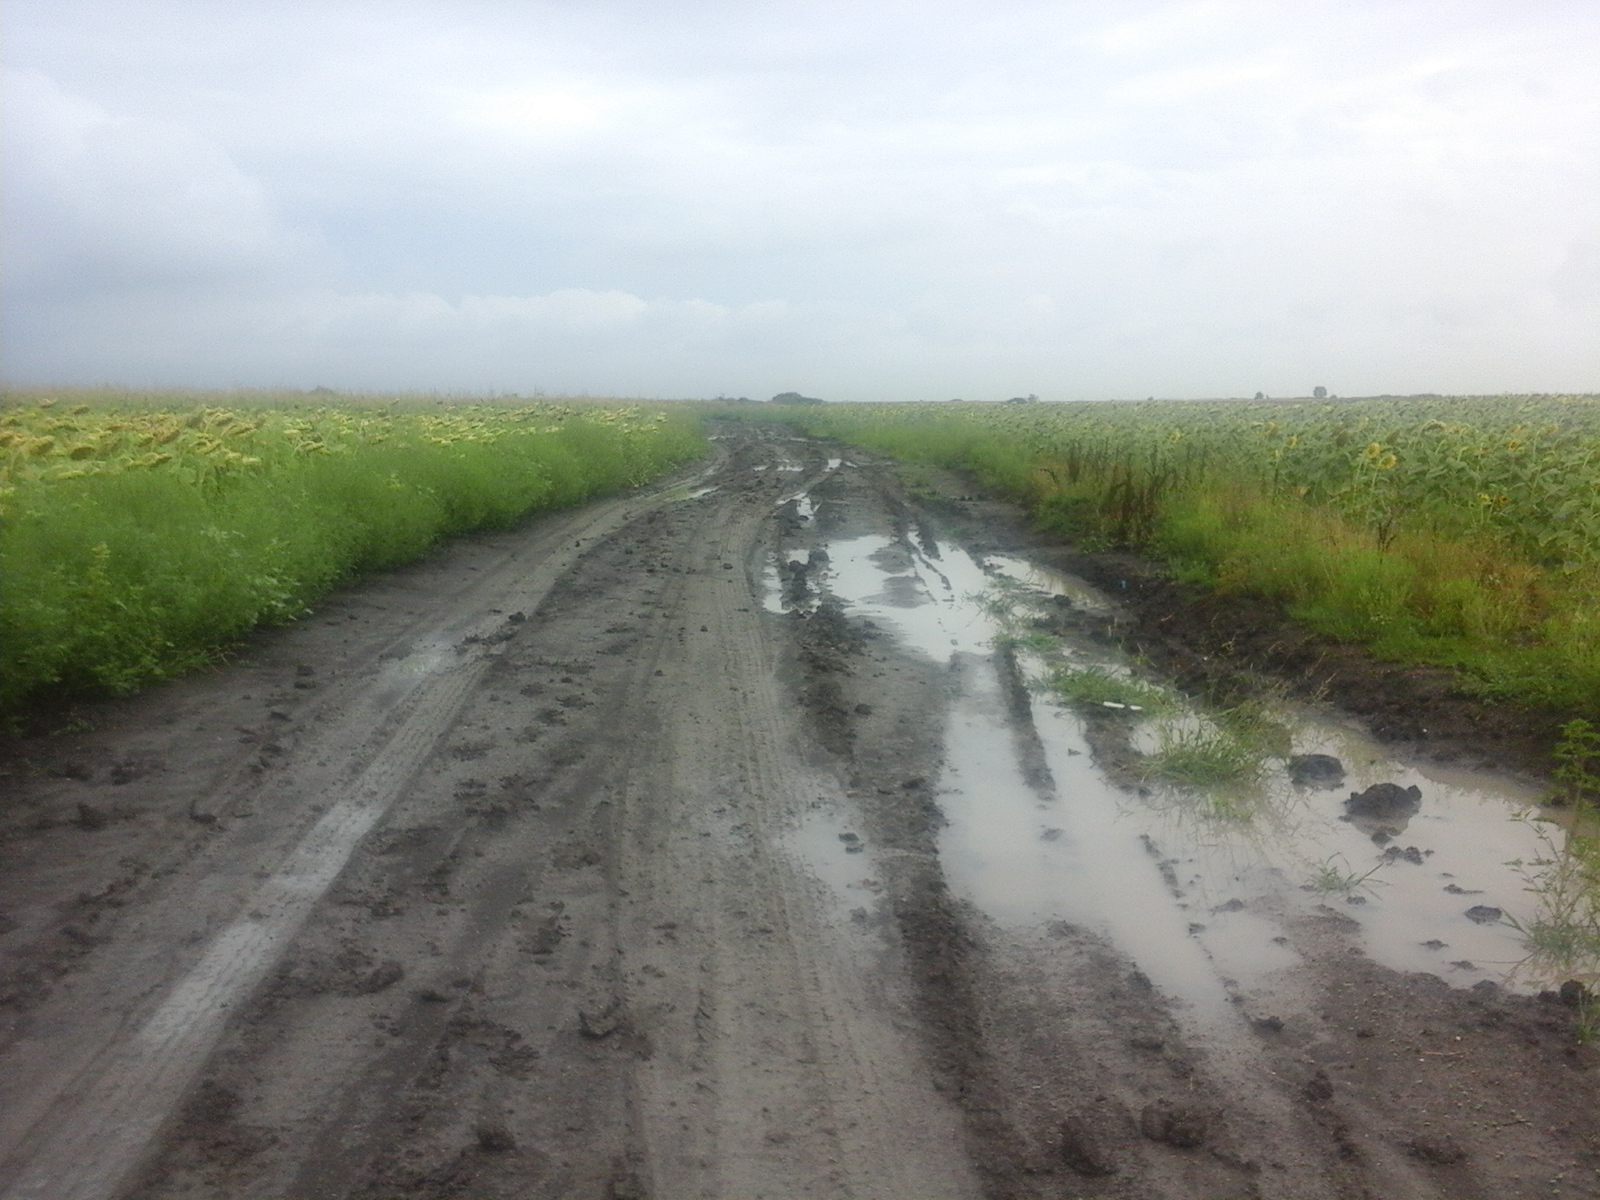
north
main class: Cropland
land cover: Sunflower
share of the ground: > 75 %
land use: Agriculture (excluding fallow land and kitchen gardens)
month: August
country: RO
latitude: 45.6021
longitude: 21.3260
